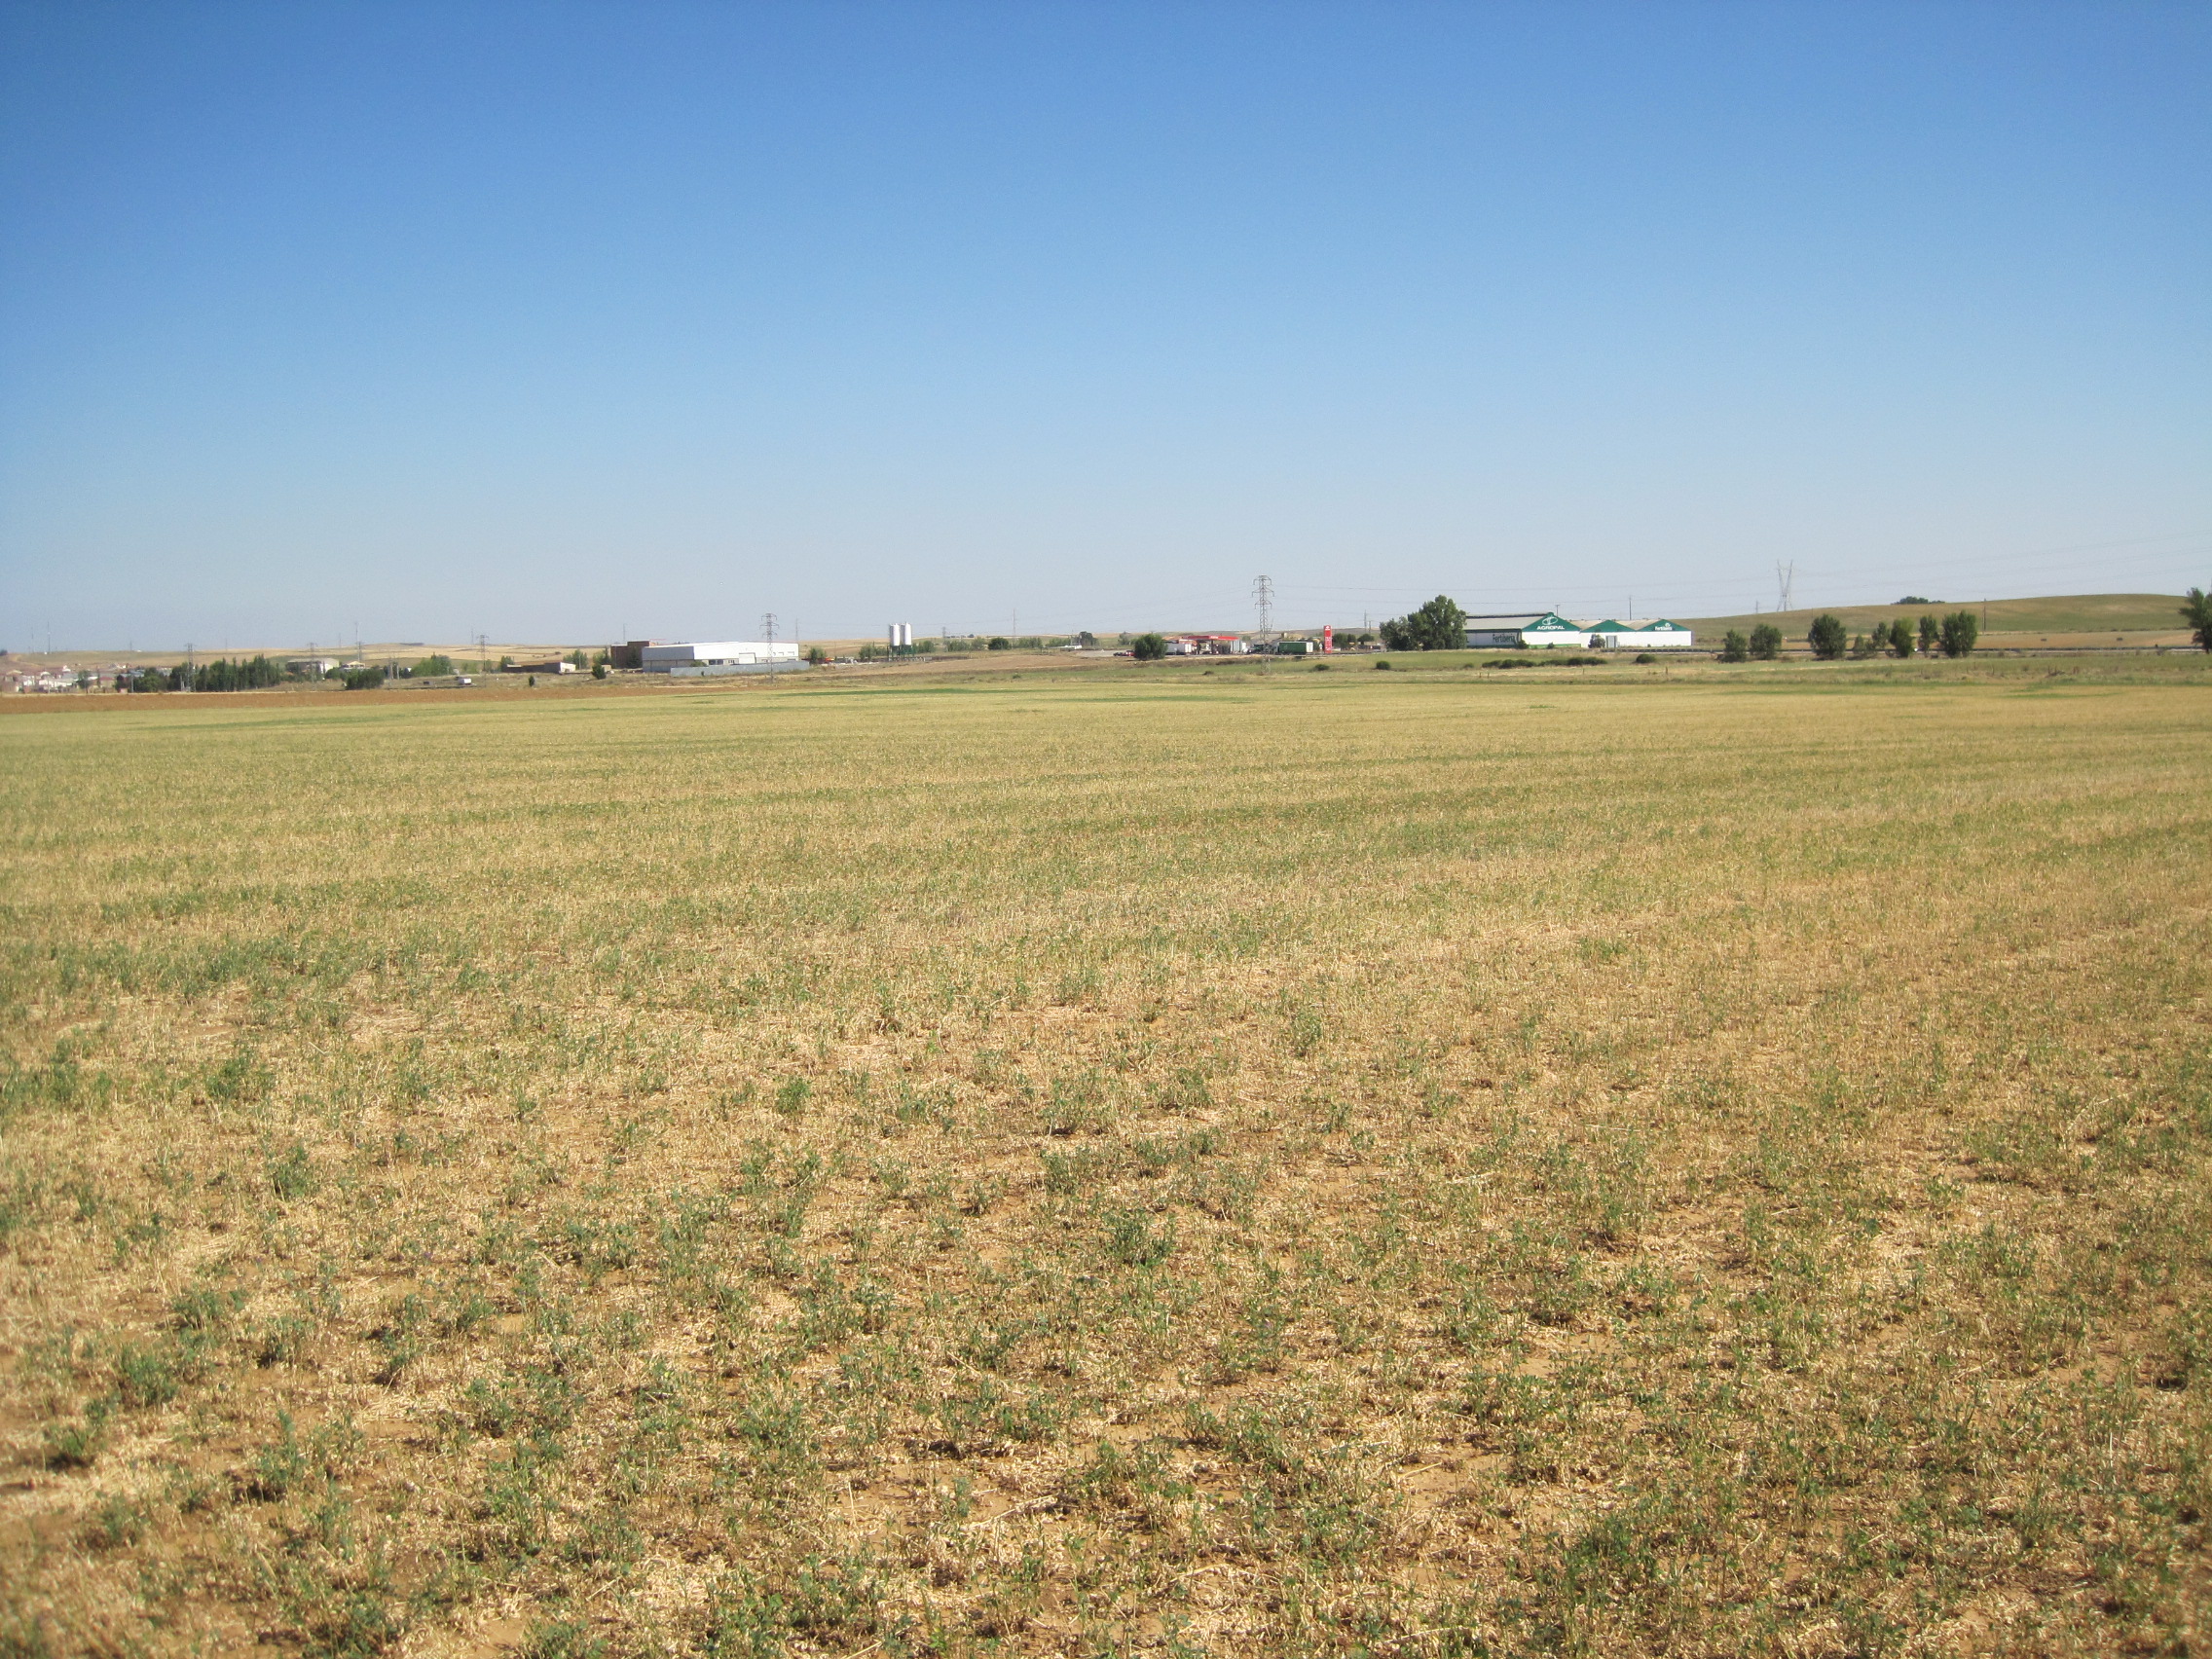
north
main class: Cropland
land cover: Lucerne
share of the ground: 25 - 50 %
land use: Agriculture (excluding fallow land and kitchen gardens)
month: July
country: ES
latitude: 42.0851
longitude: -5.2067
